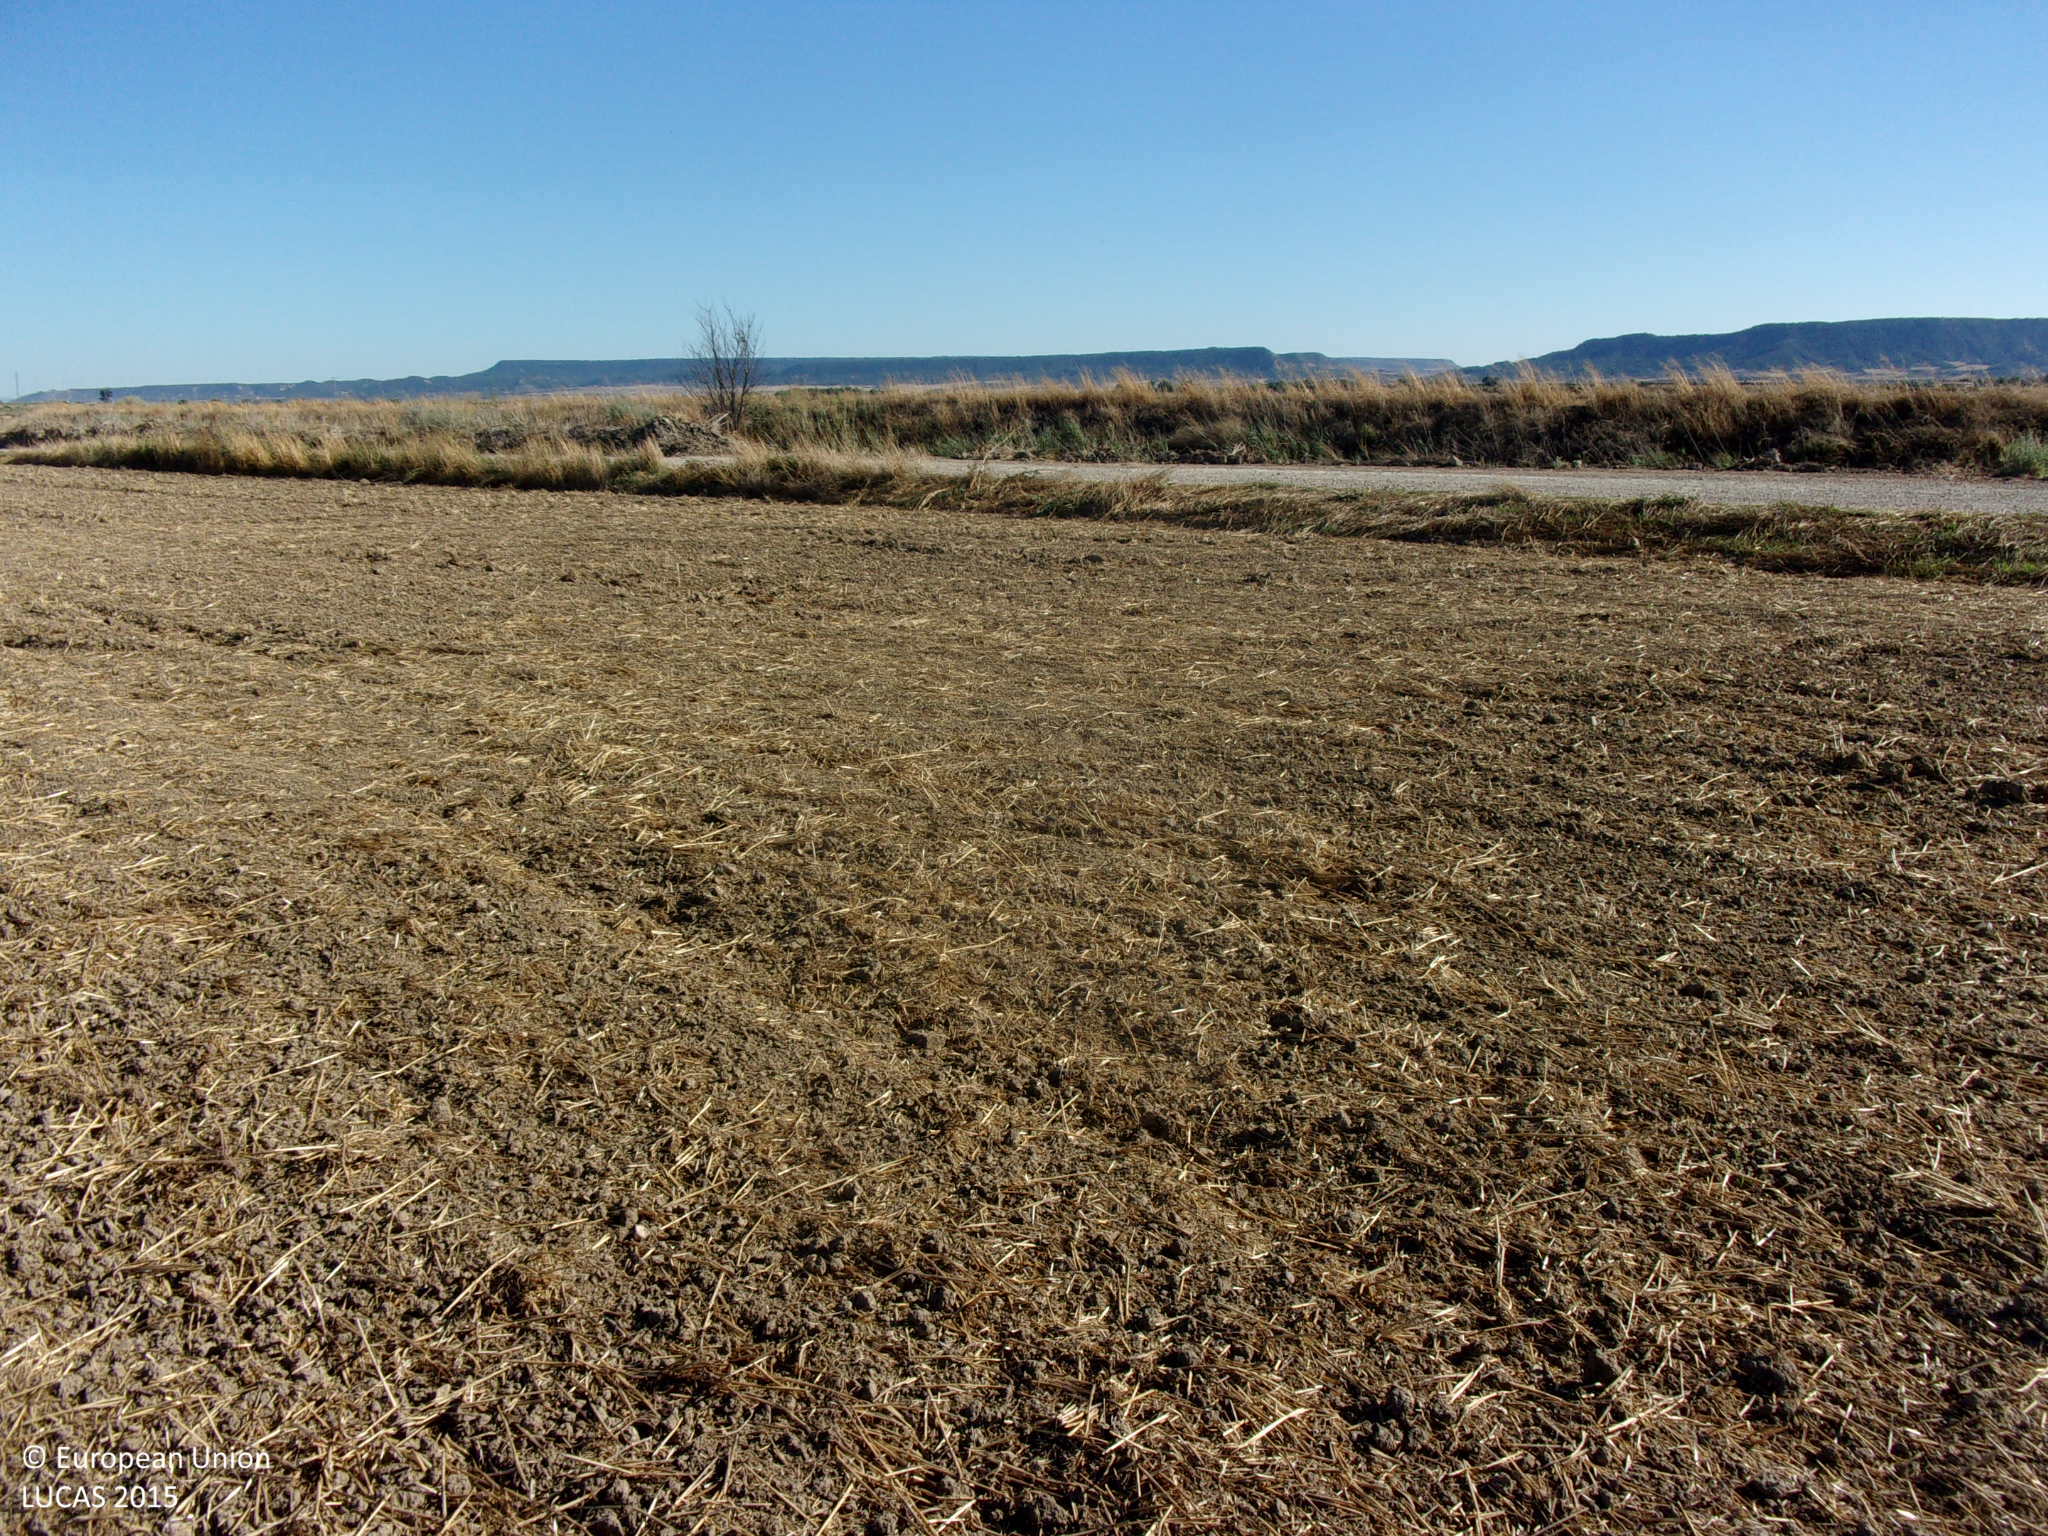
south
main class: Cropland
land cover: Common wheat
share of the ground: < 10 %
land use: Agriculture (excluding fallow land and kitchen gardens)
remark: Harvested field
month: August
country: ES
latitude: 42.1957
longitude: -1.3535
